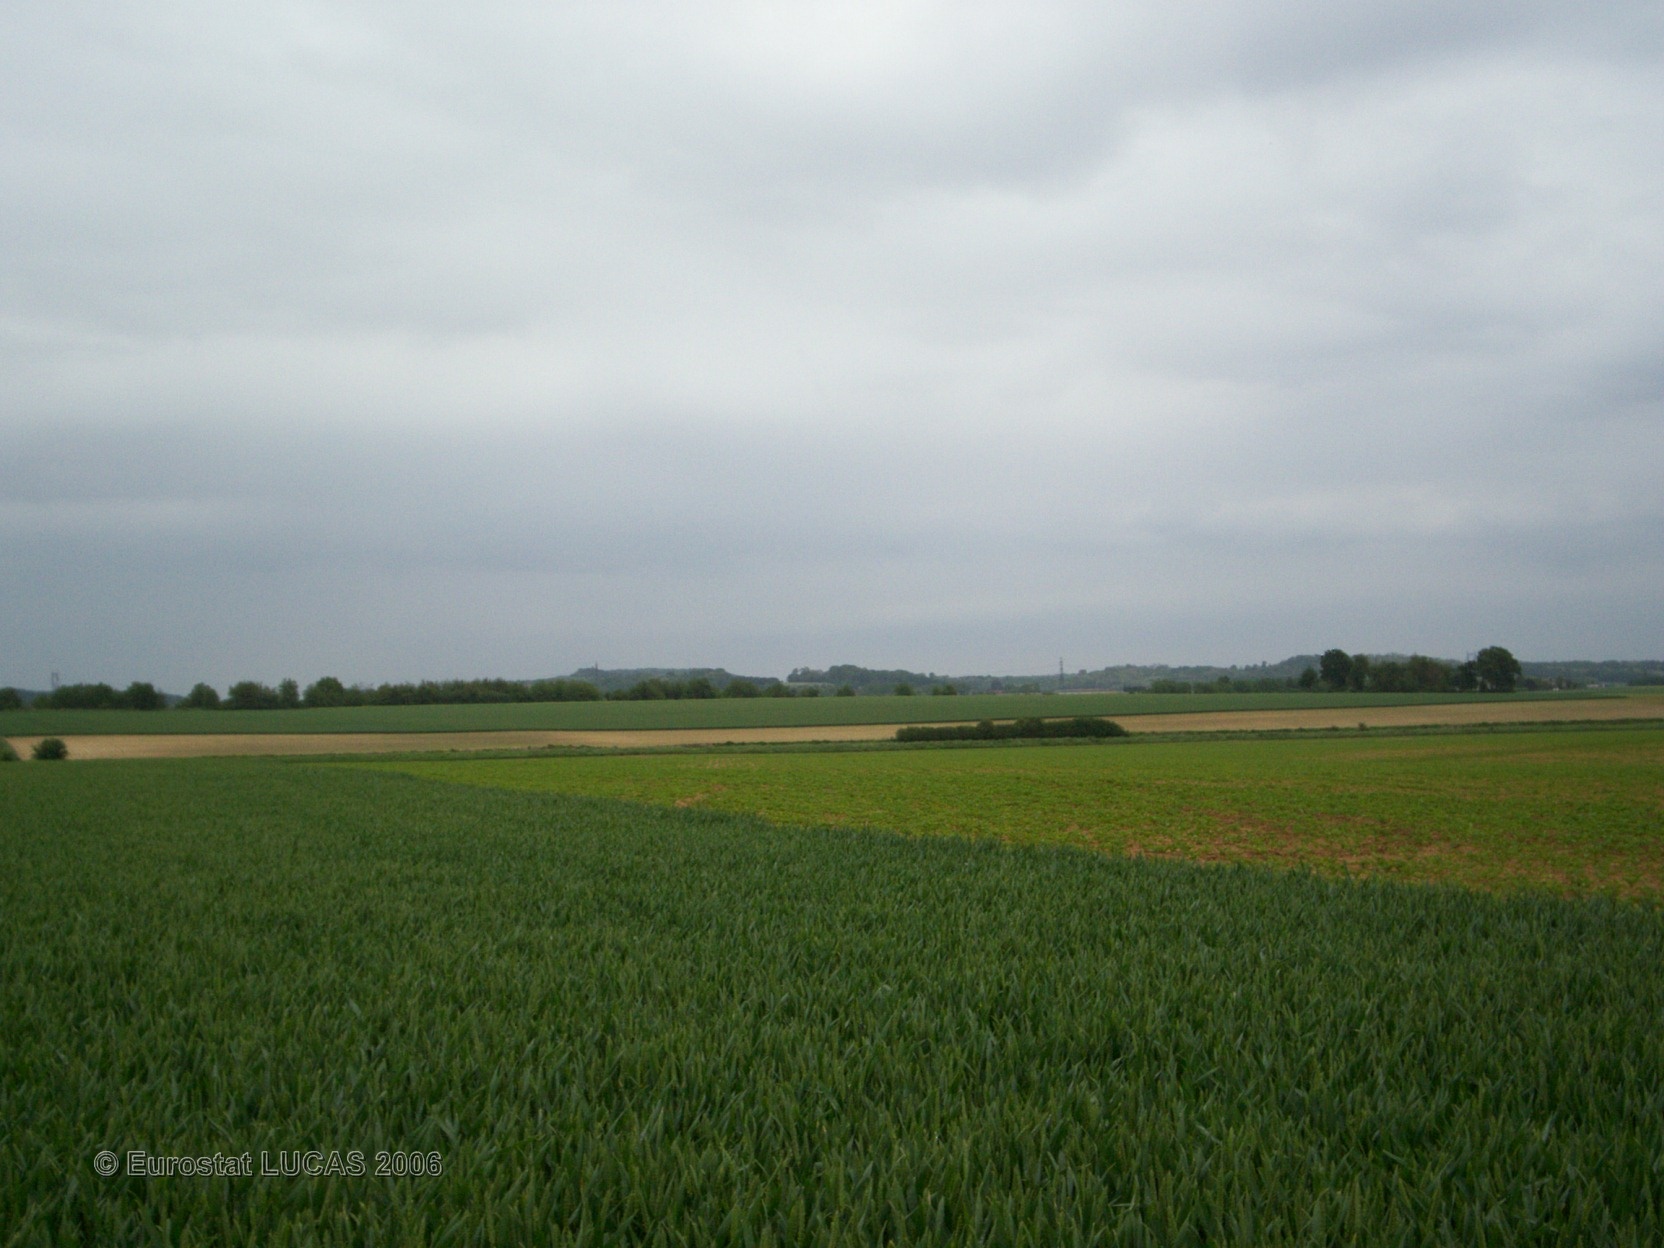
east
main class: Cropland
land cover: Common wheat
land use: Agriculture (excluding fallow land and kitchen gardens)
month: June
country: FR
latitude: 49.3886
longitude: 2.6736
